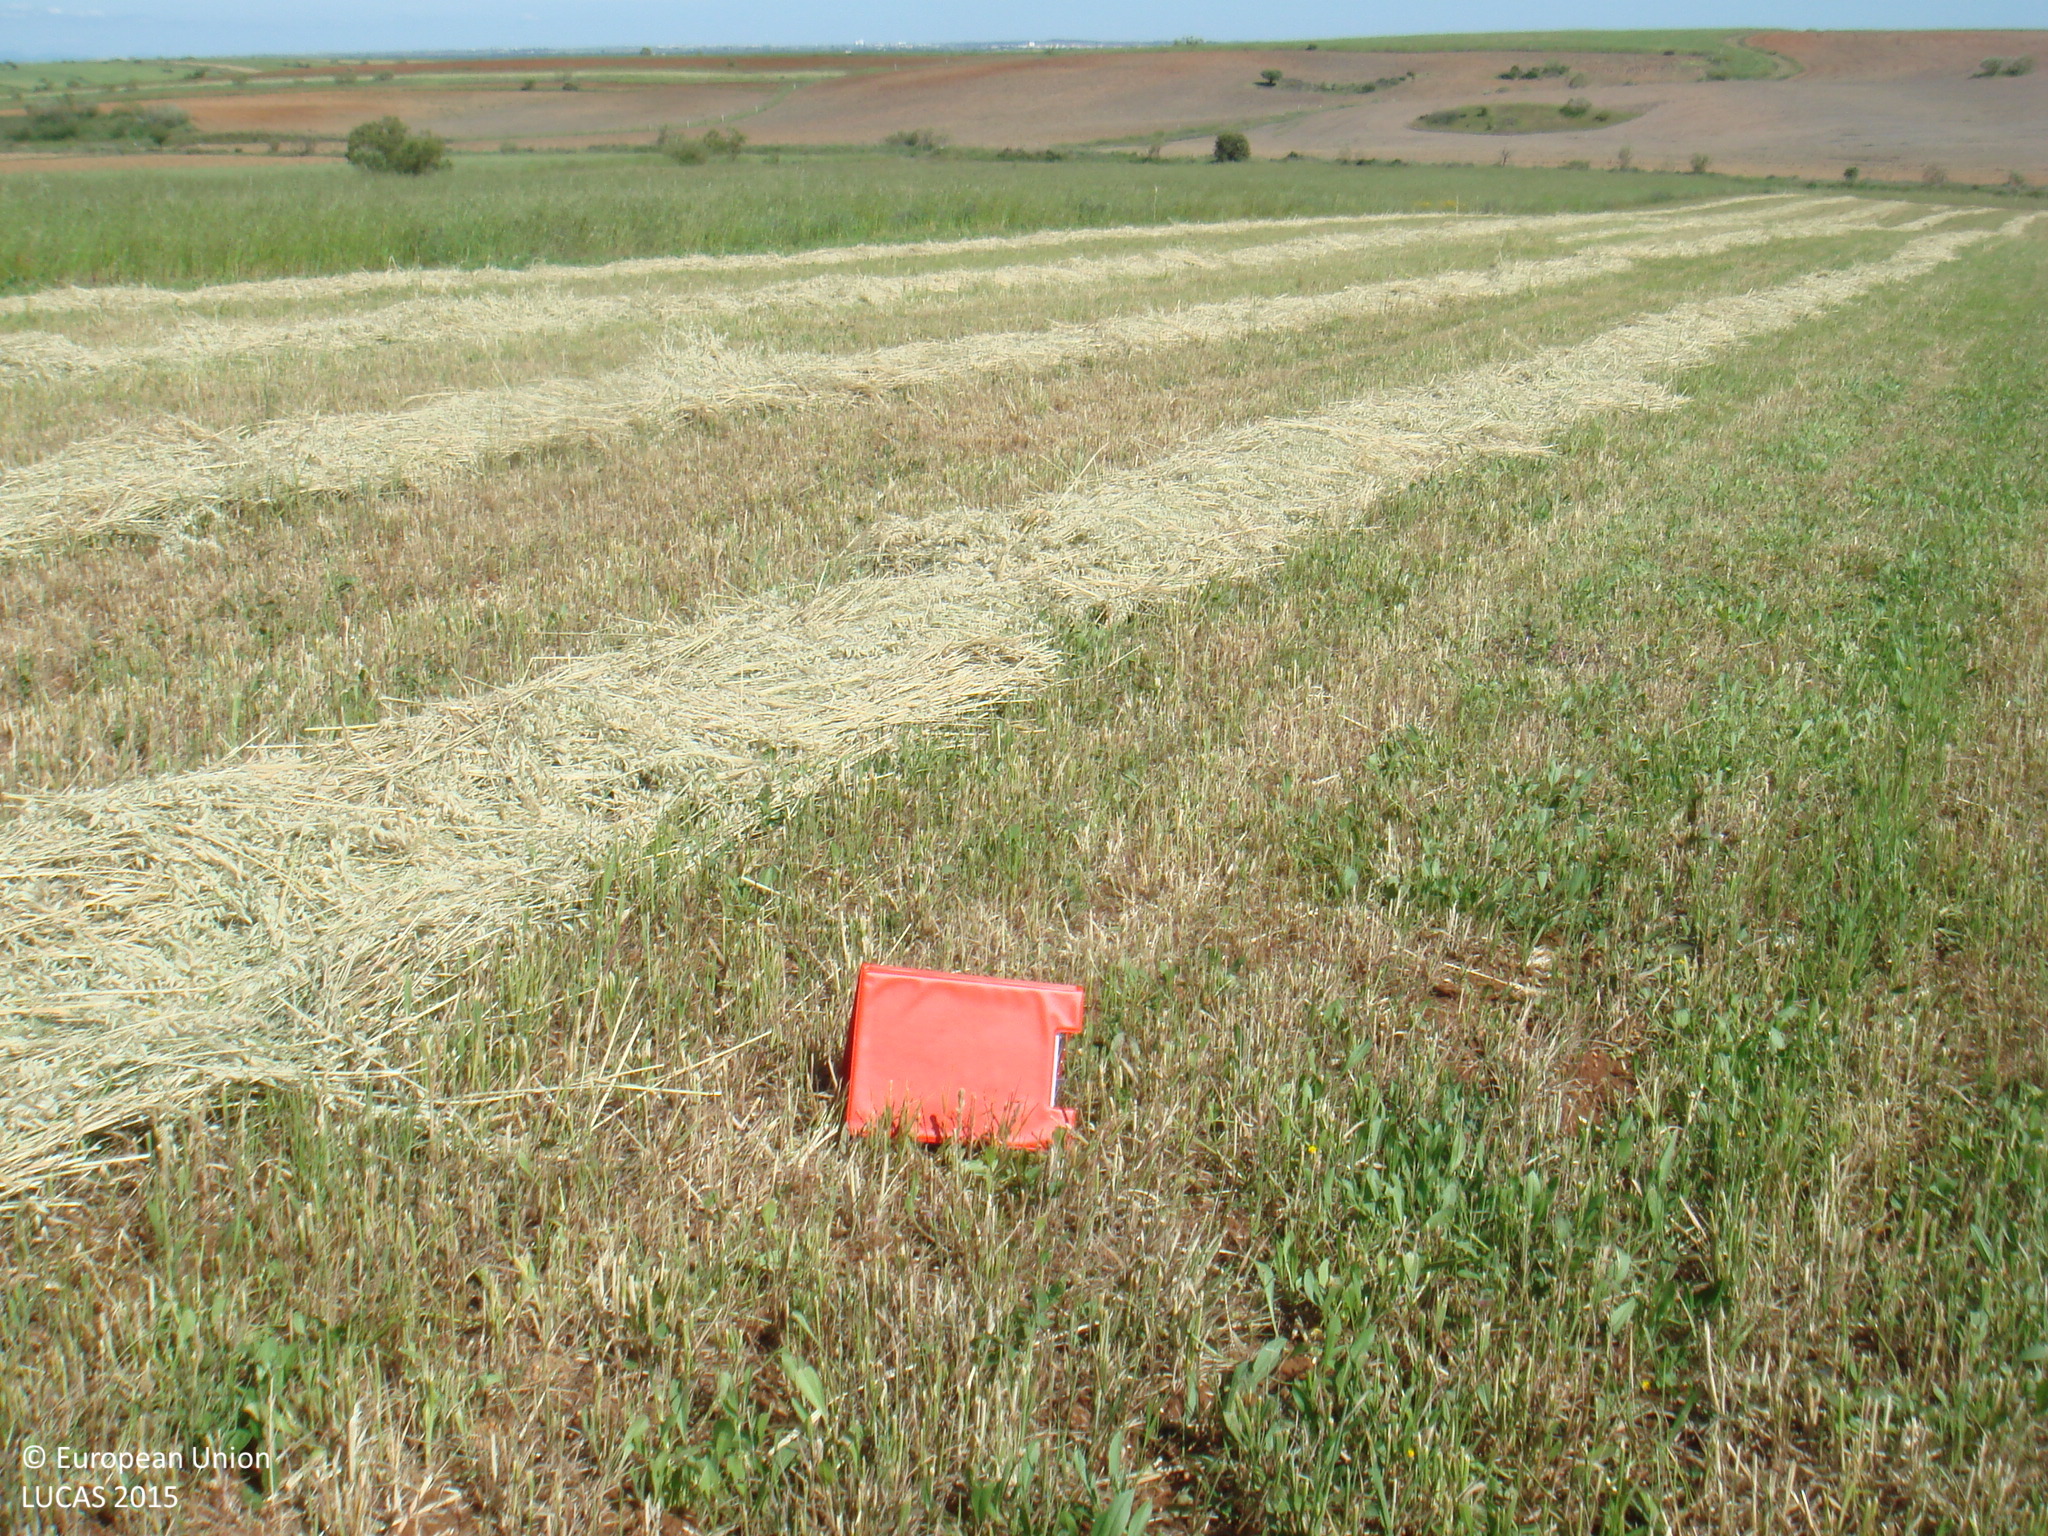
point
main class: Grassland
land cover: Grassland without tree/shrub cover
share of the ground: > 75 %
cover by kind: consolidated bare surface 80 %, herbaceous plants 20 %
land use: Agriculture (excluding fallow land and kitchen gardens)
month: April
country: ES
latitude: 38.4449
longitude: -5.1182
